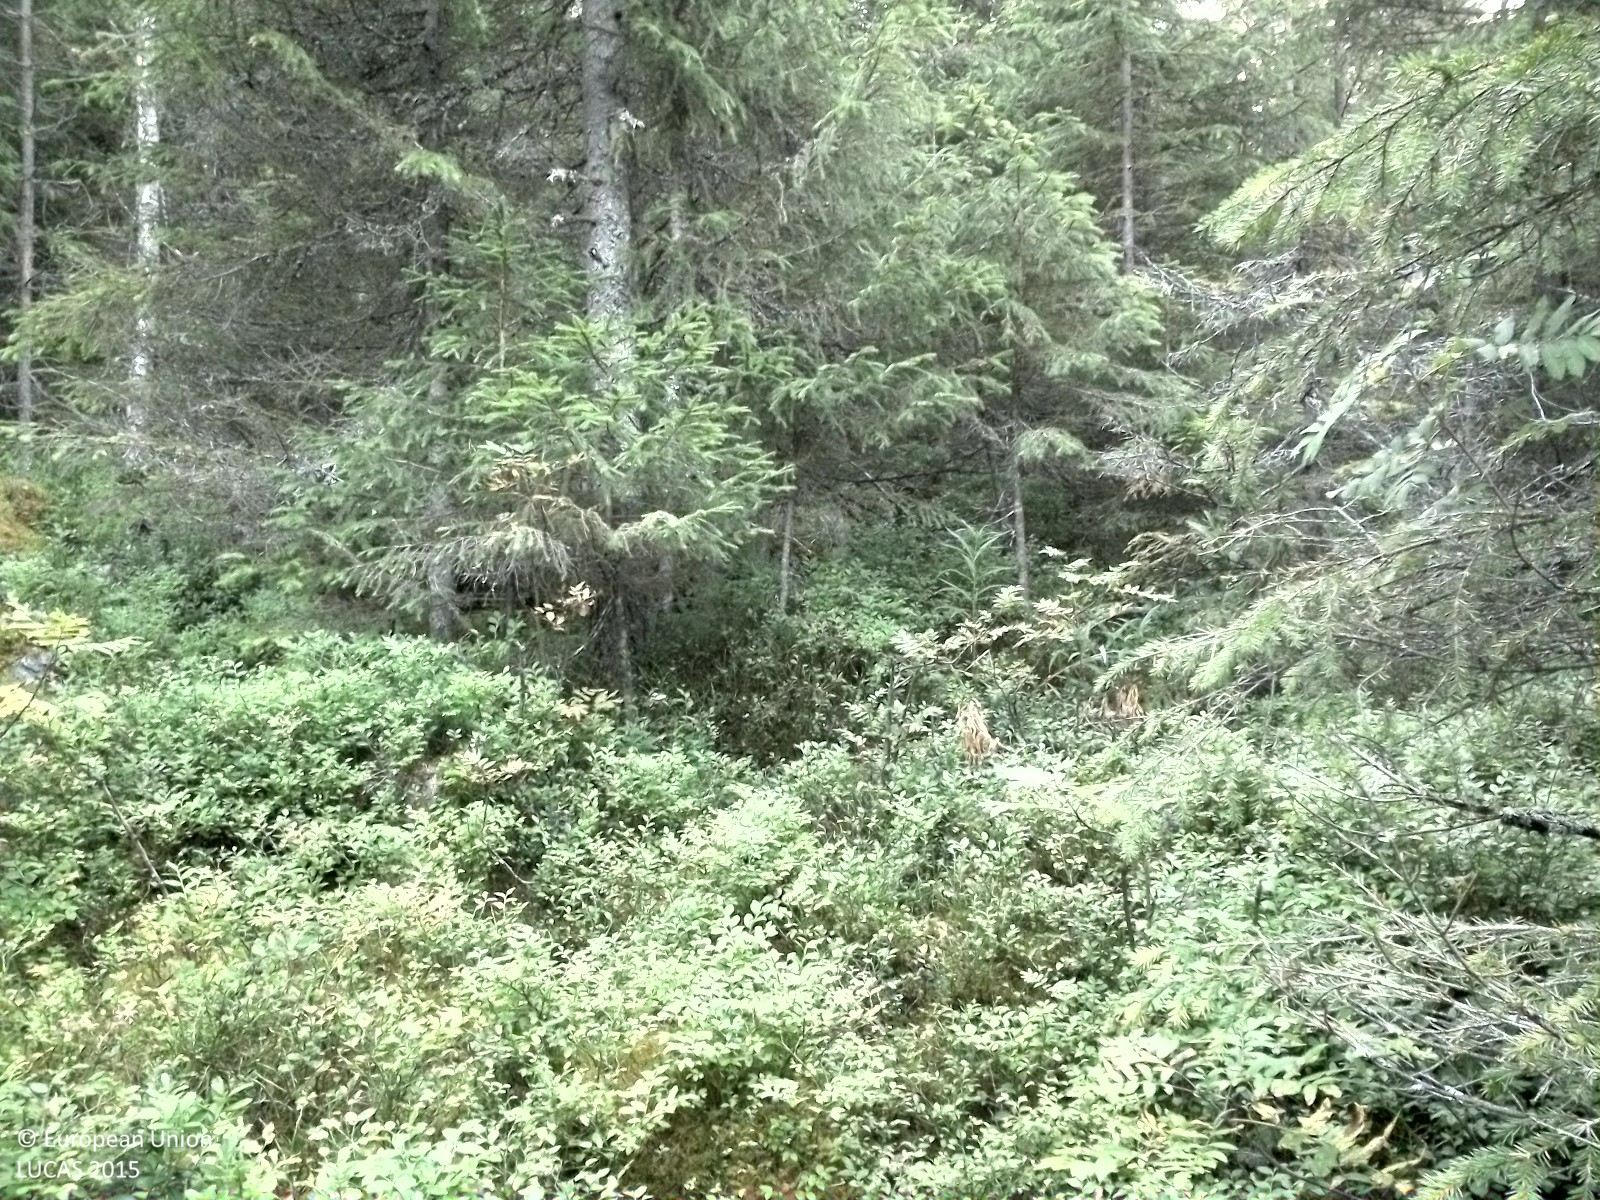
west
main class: Woodland
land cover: Spruce dominated coniferous woodland
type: boreal forest
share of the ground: 50 - 75 %
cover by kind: coniferous forest trees 60 %, shrubs 35 %, broadleaved forest trees 5 %
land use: Forestry
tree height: > 5 m
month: August
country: SE
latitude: 62.2753
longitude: 16.0112
